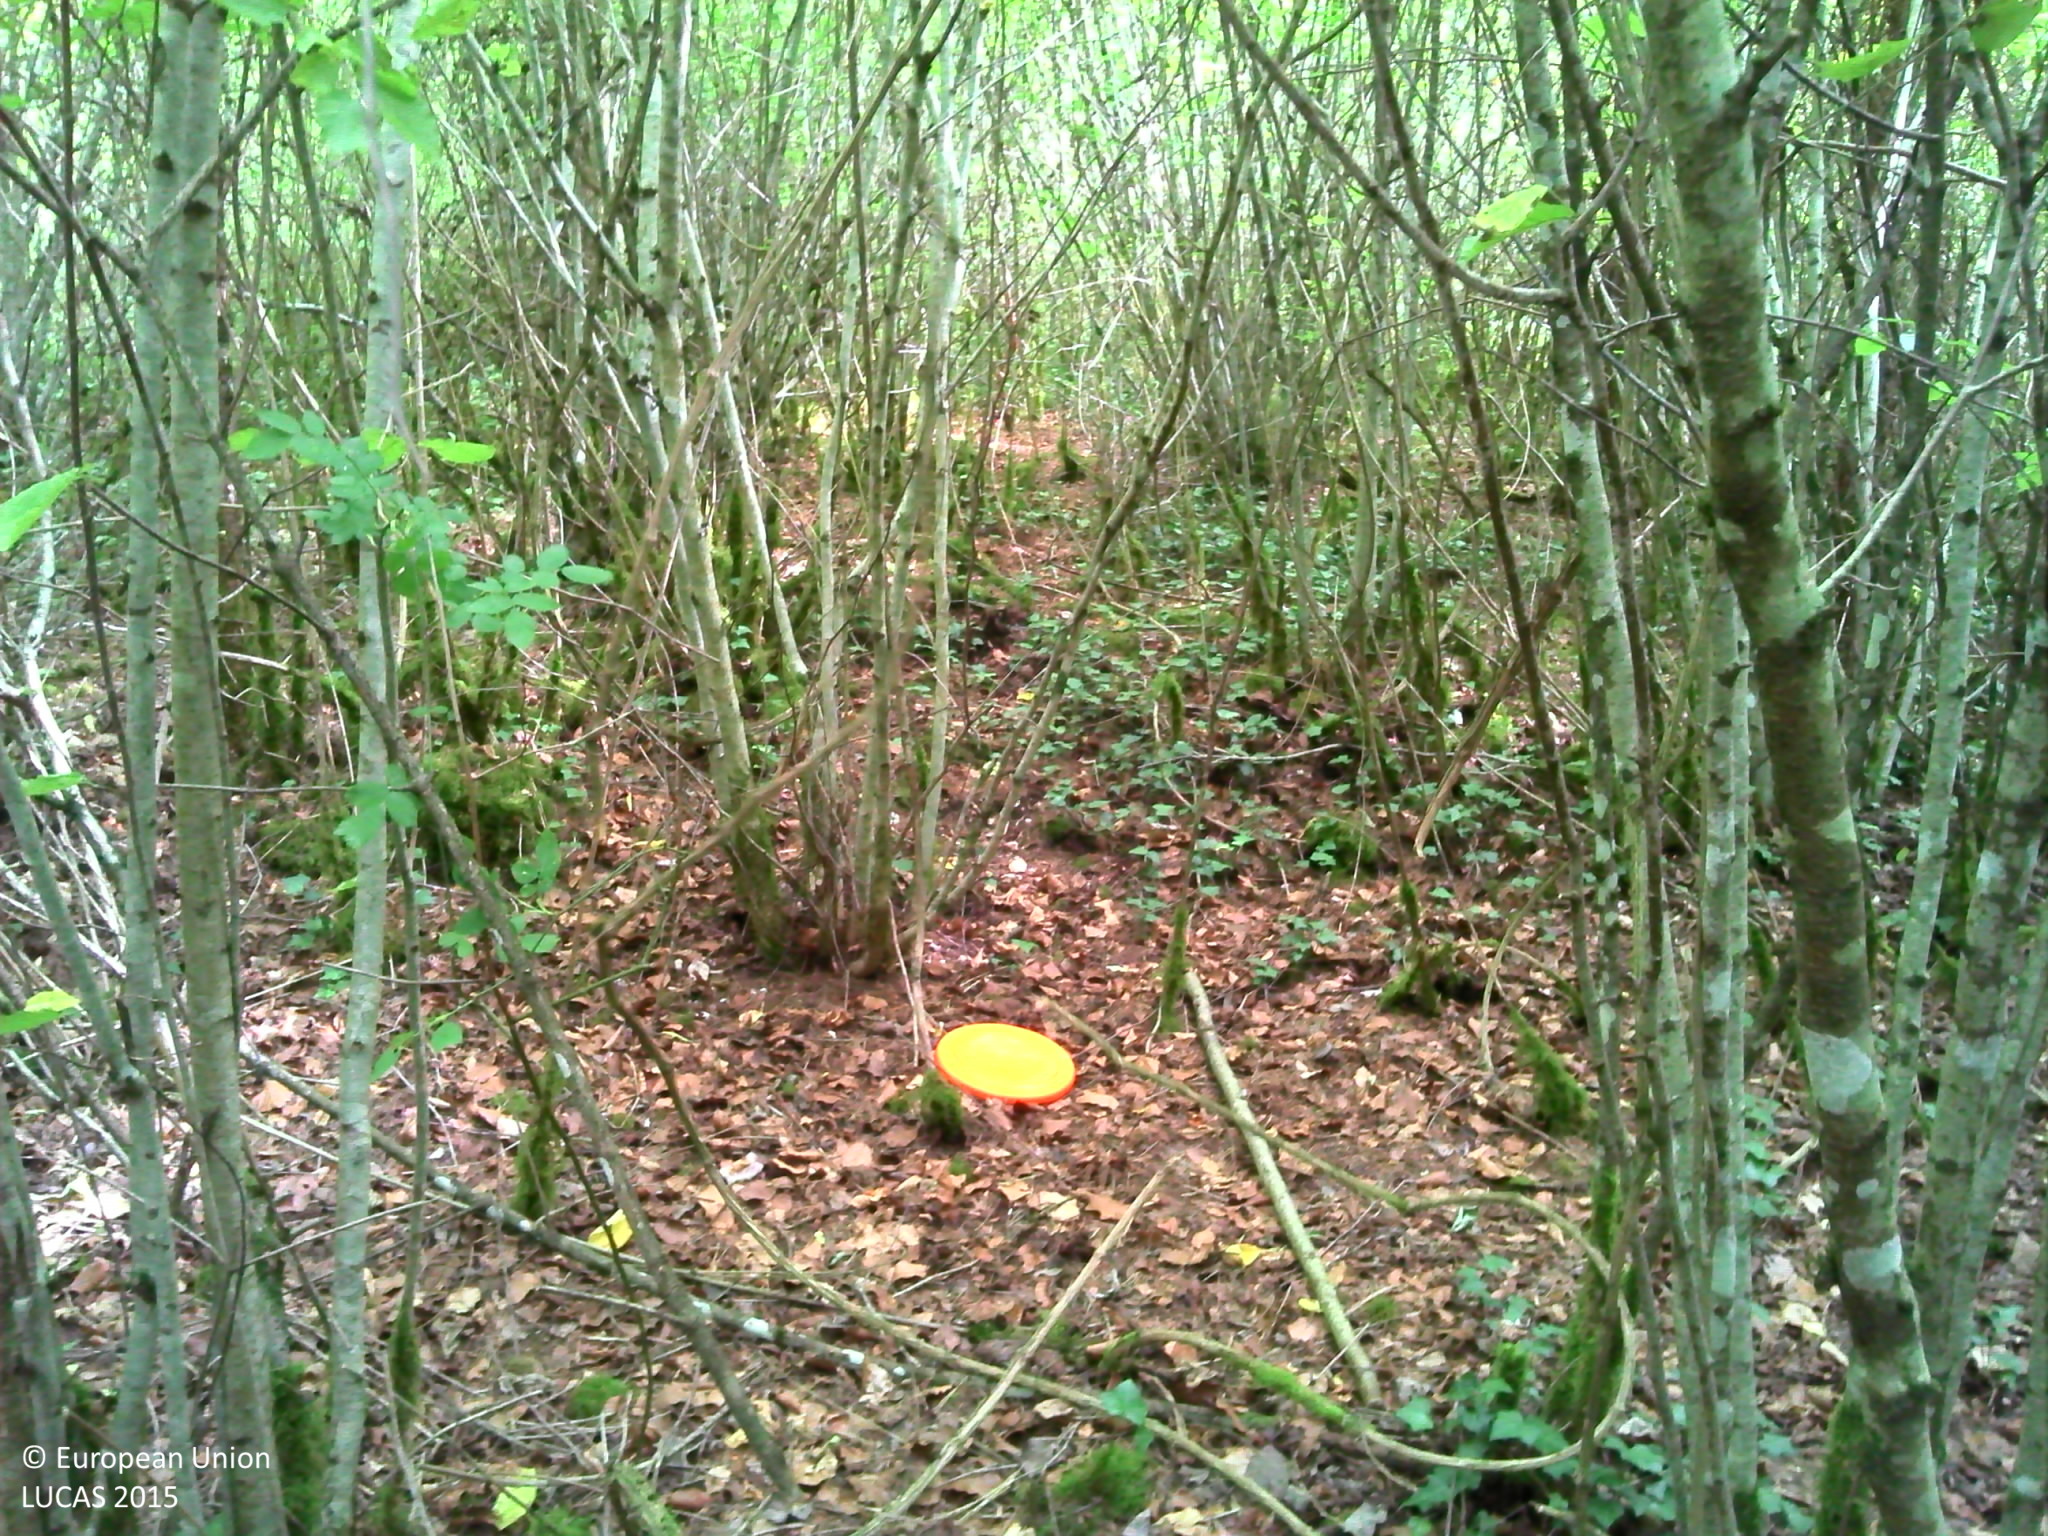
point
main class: Woodland
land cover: Other mixed woodland
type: exotic forest
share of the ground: > 75 %
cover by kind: coniferous forest trees 50 %, broadleaved forest trees 40 %, herbaceous plants 5 %, lichens and mosses 5 %
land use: Forestry
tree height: > 5 m
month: August
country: FR
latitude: 47.6919
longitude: 4.9232
